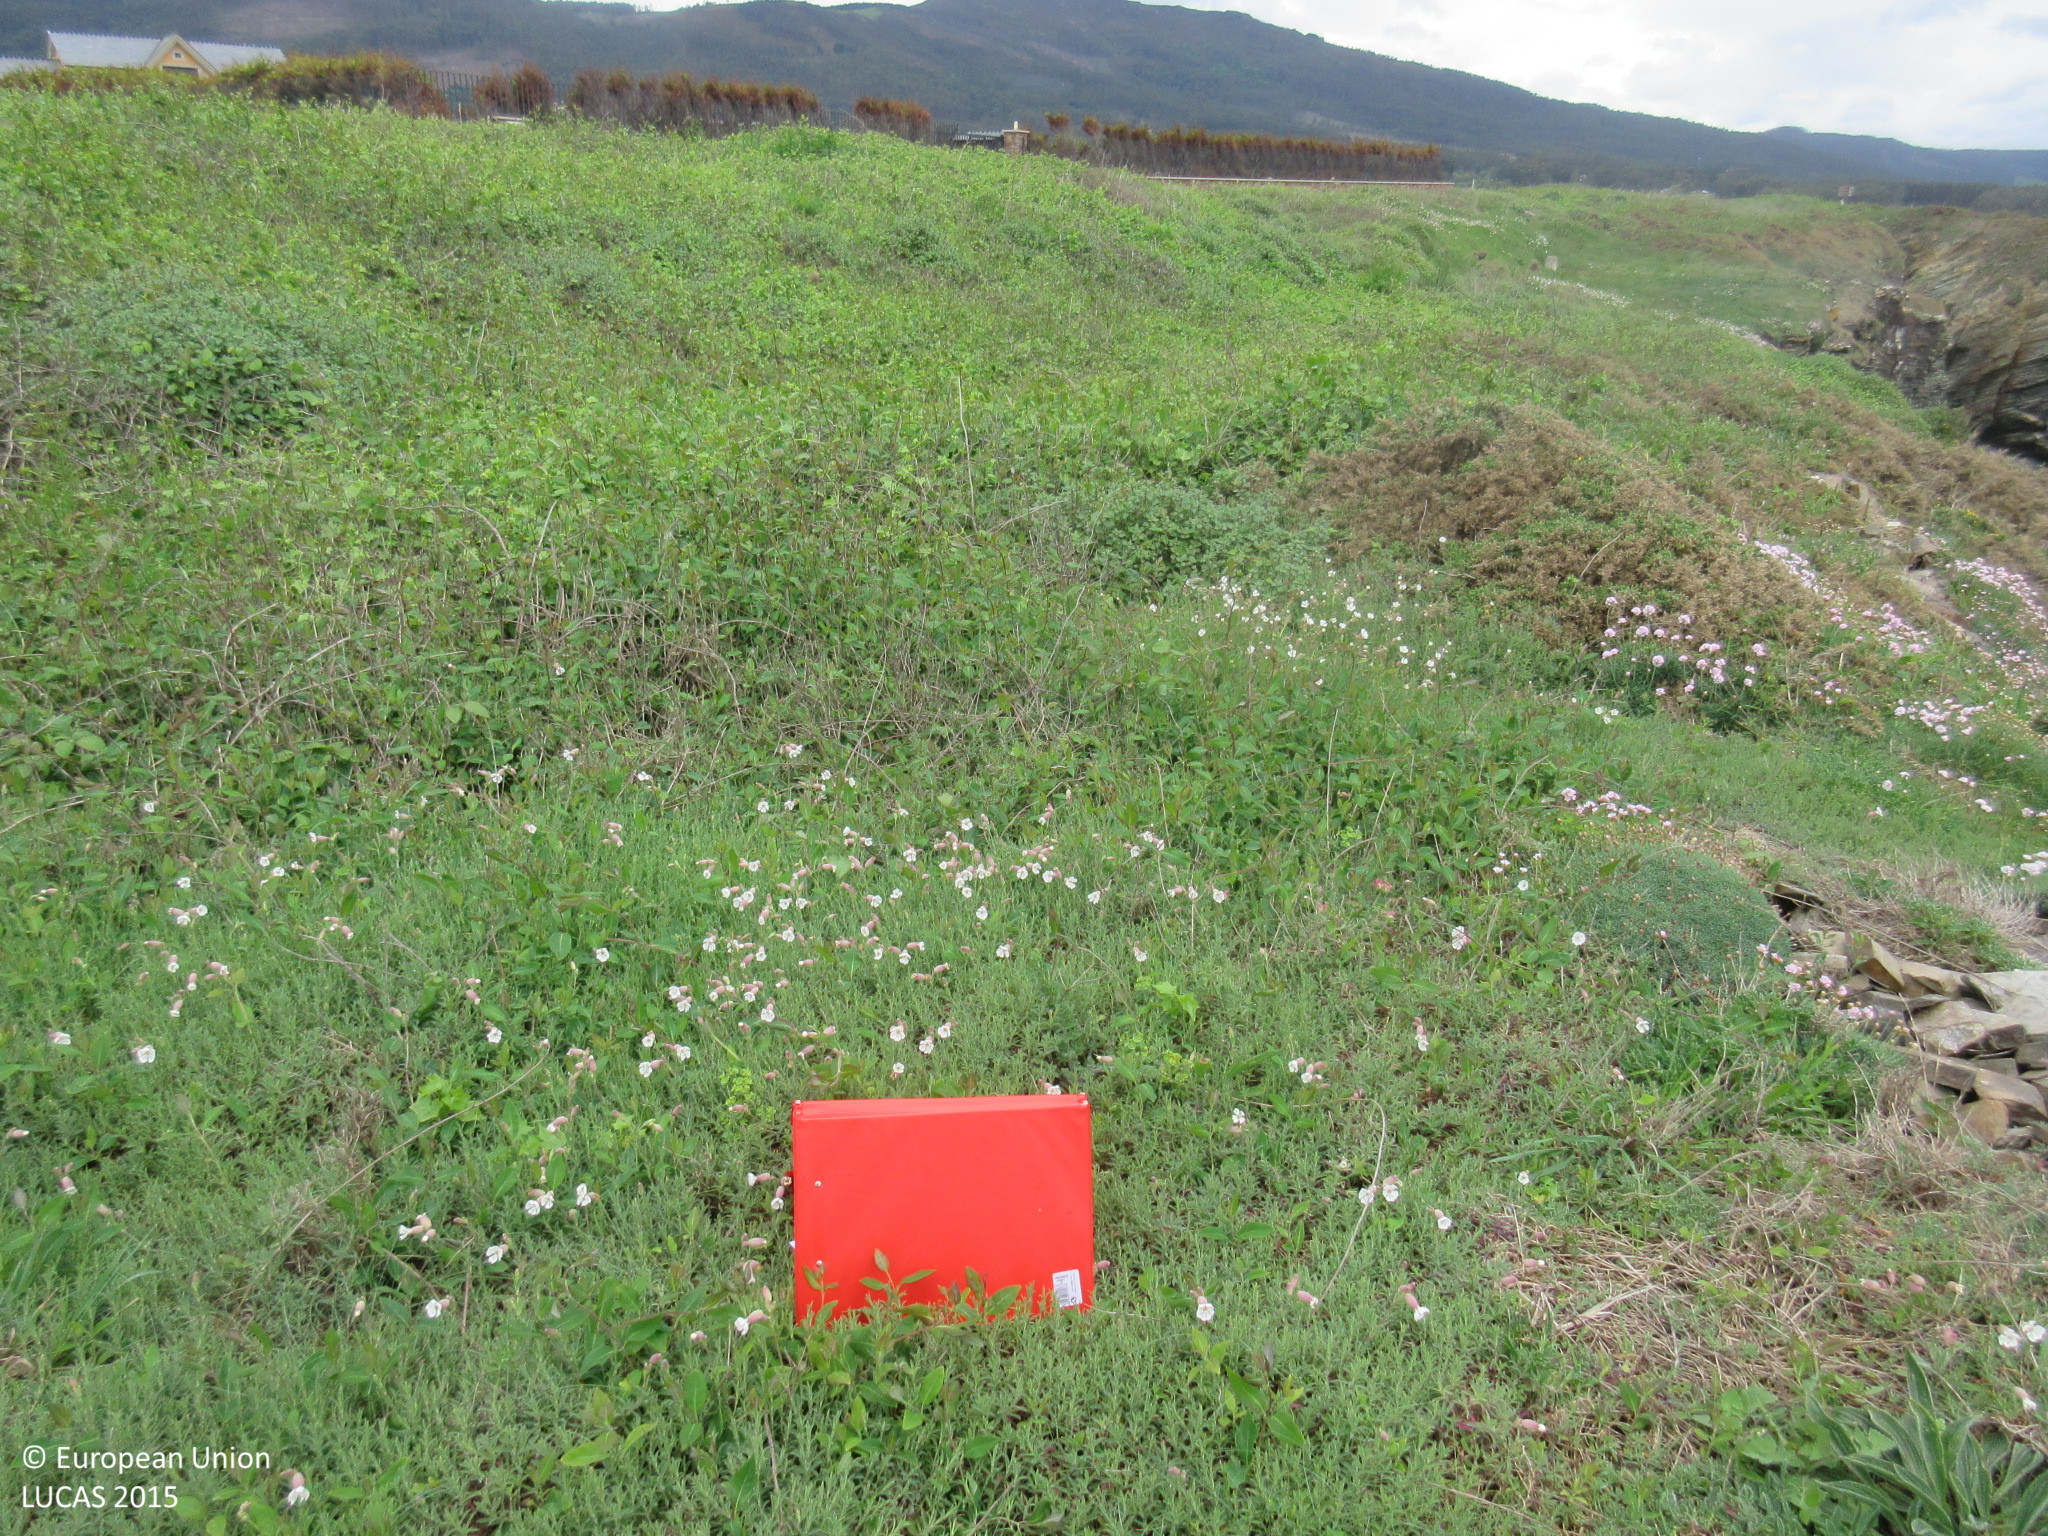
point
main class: Shrubland
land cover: Shrubland without tree cover
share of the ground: > 75 %
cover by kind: herbaceous plants 80 %, shrubs 20 %
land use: Semi-natural and natural areas not in use
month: April
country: ES
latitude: 43.5553
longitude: -7.1427
